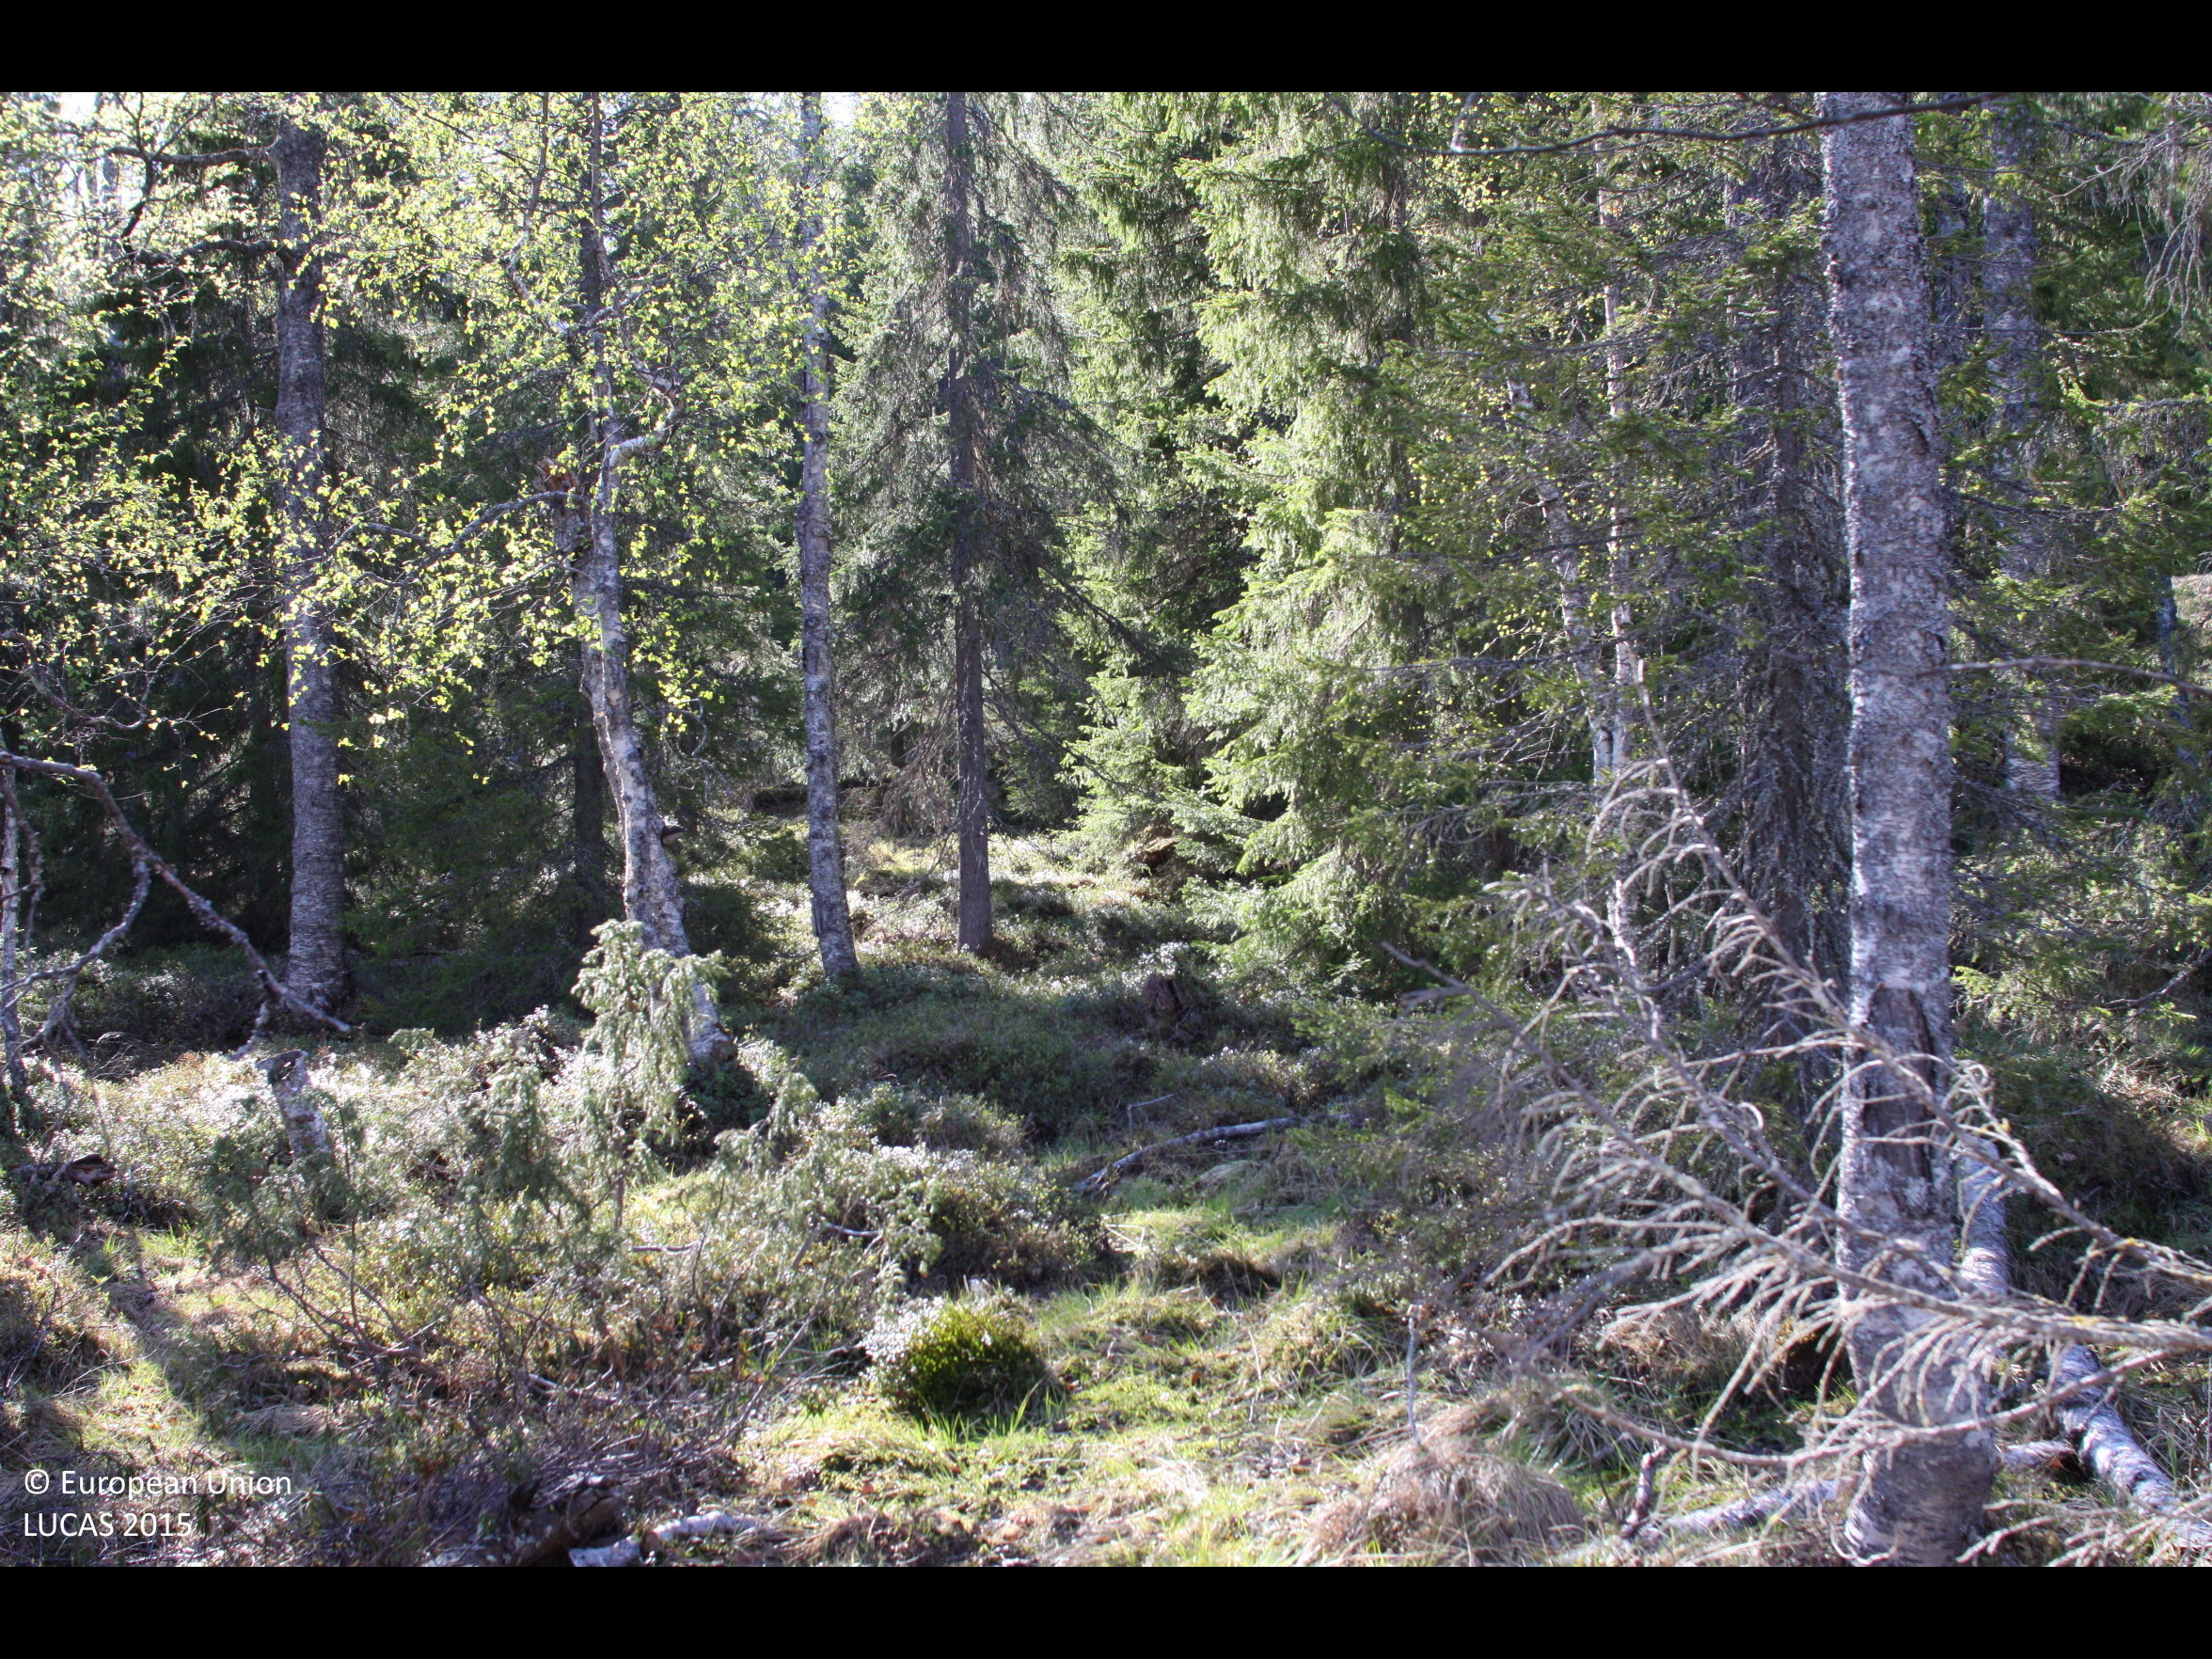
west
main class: Woodland
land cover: Spruce dominated mixed woodland
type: boreal forest
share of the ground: > 75 %
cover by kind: coniferous forest trees 45 %, broadleaved forest trees 35 %, herbaceous plants 10 %, lichens and mosses 10 %
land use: Forestry
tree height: > 5 m
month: June
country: FI
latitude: 66.2462
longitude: 27.4936
